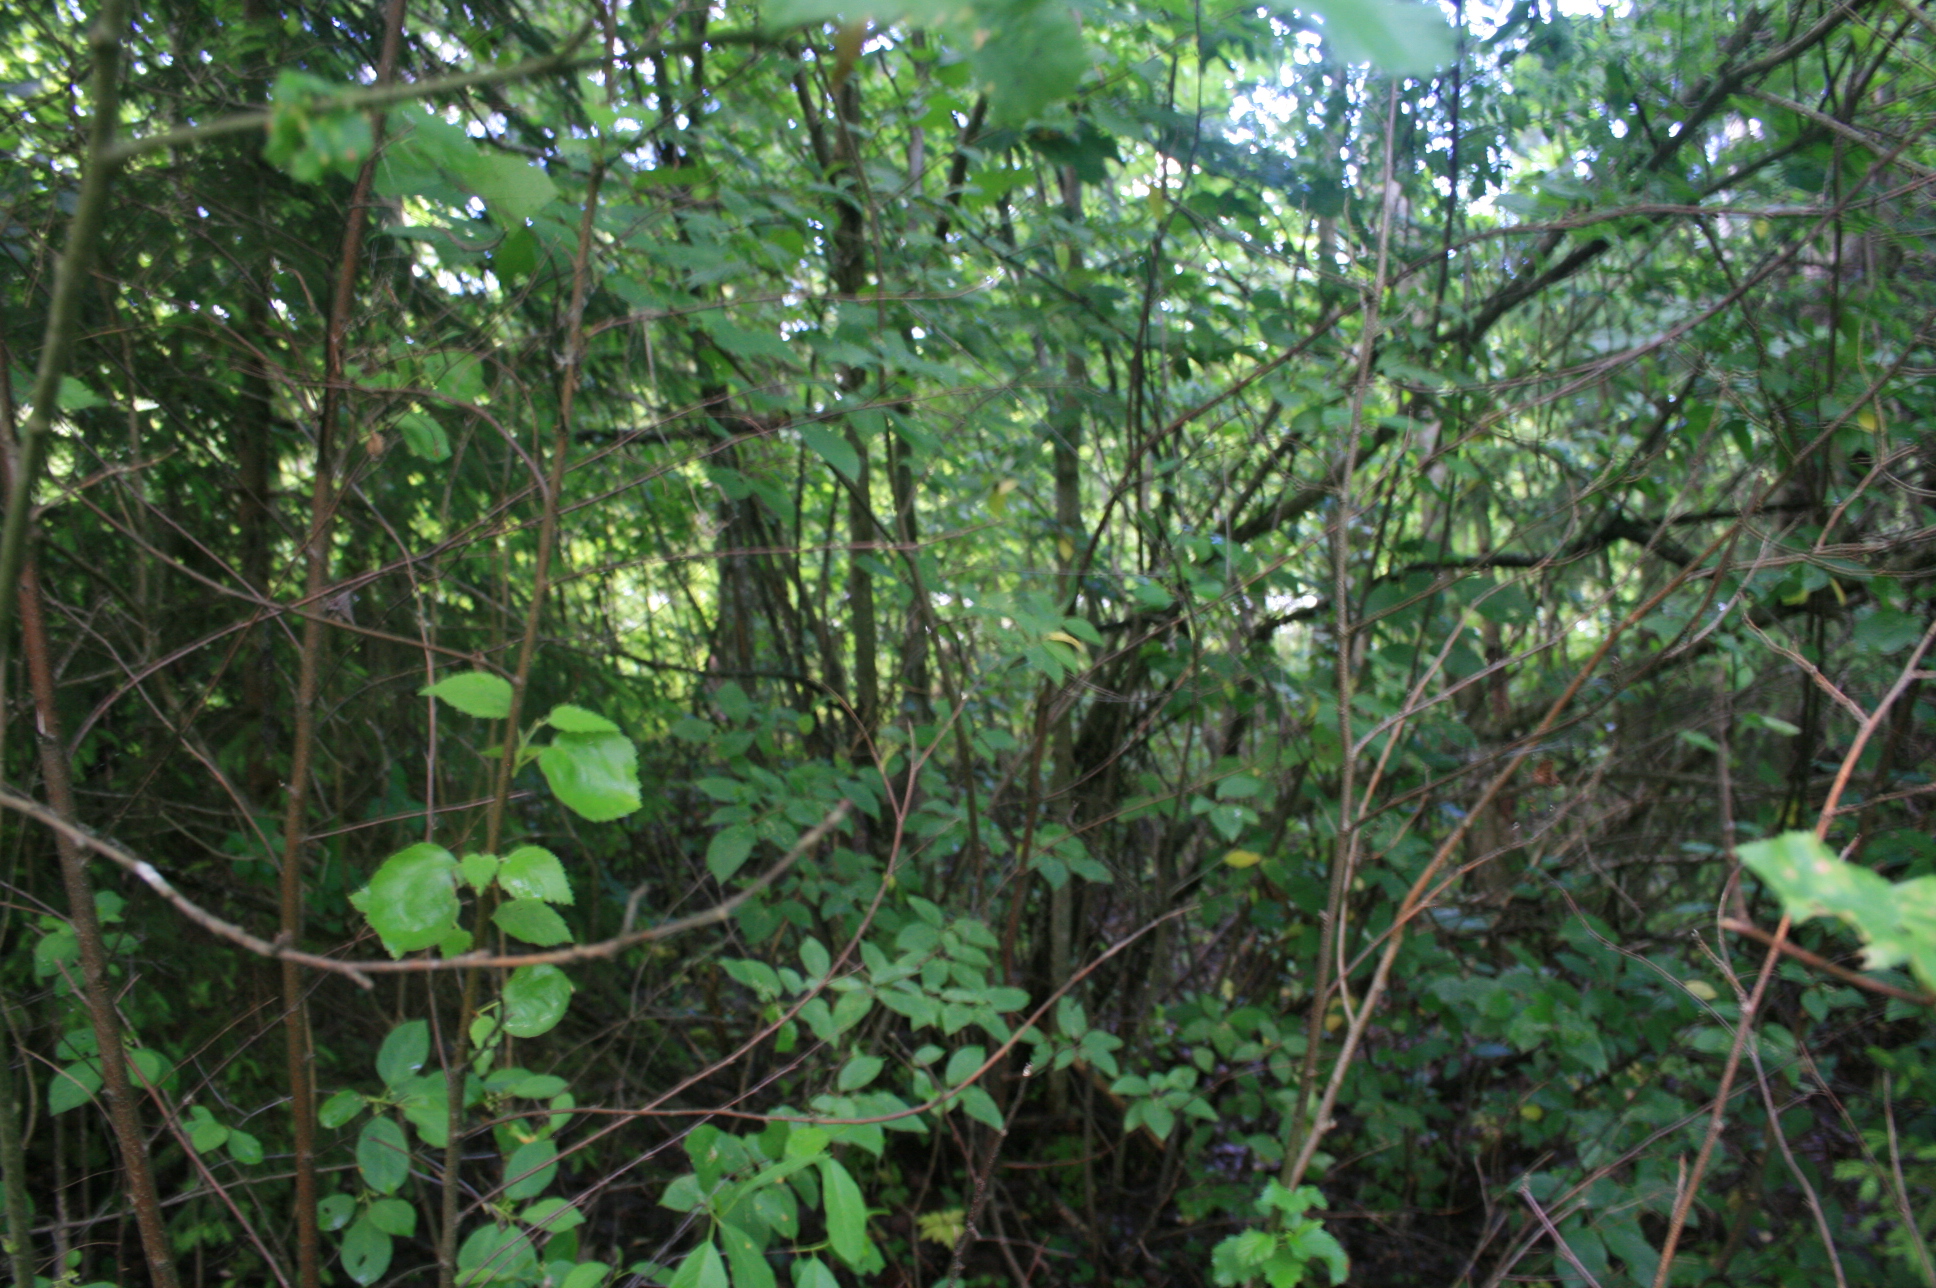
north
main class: Woodland
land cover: Spruce dominated mixed woodland
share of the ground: > 75 %
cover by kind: broadleaved forest trees 70 %, coniferous forest trees 30 %
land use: Forestry
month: June
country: LT
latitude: 55.4794
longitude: 22.1598
